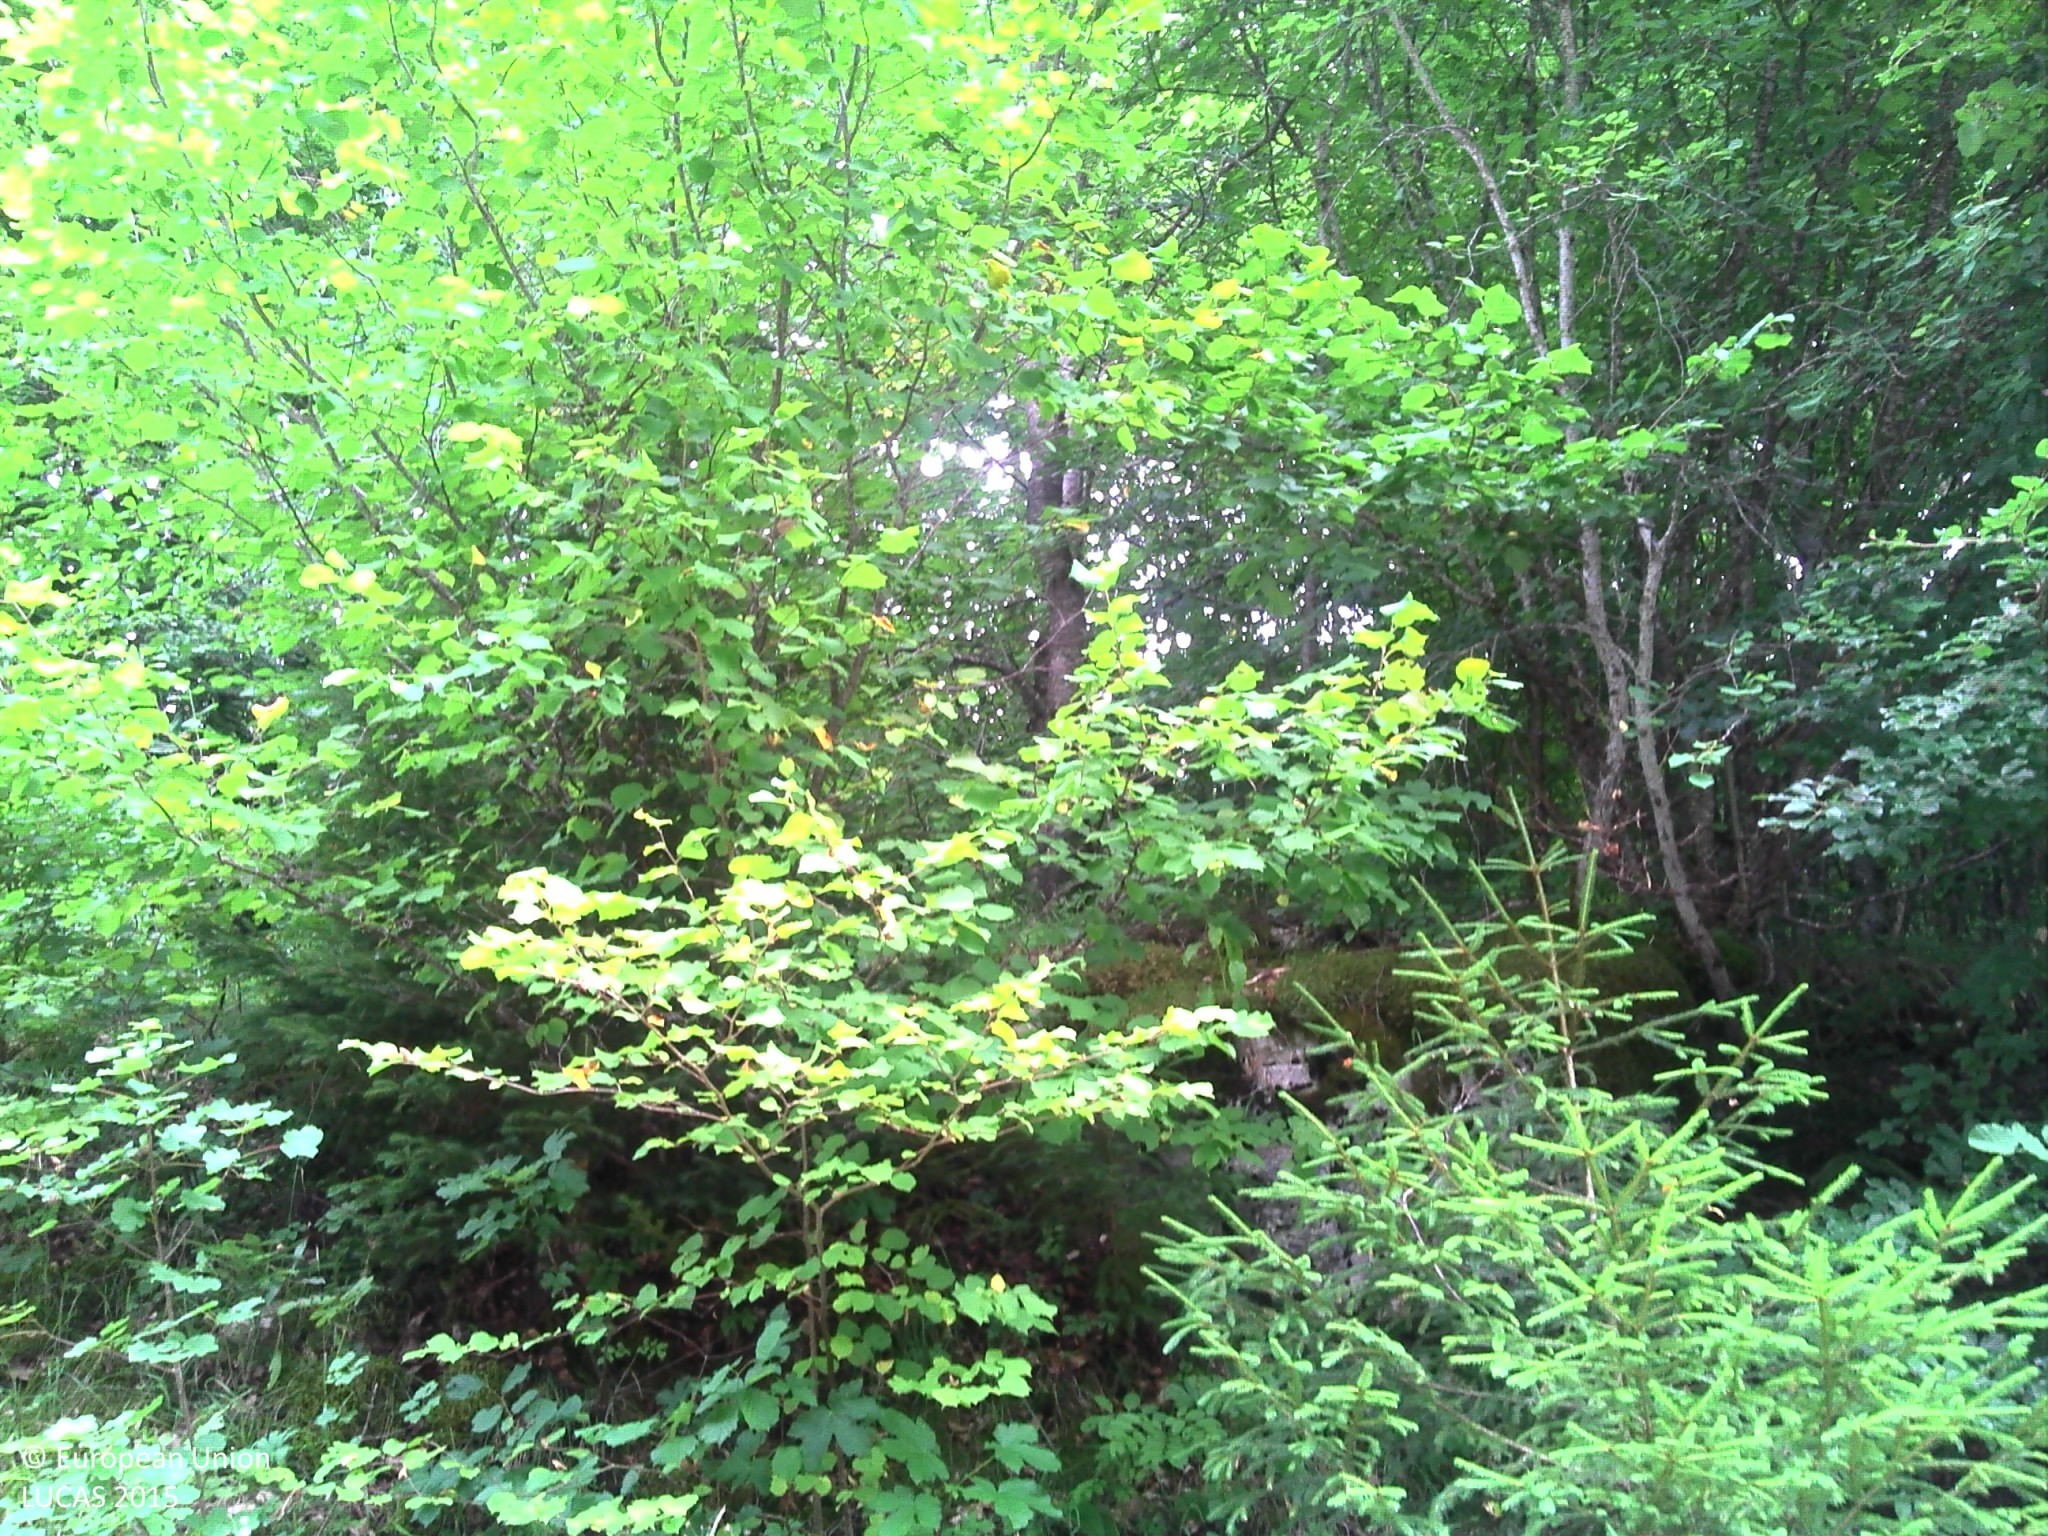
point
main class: Woodland
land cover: Other mixed woodland
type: alpine coniferous forest
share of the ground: > 75 %
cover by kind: coniferous forest trees 55 %, broadleaved forest trees 40 %, unconsolidated bare surface 5 %
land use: Semi-natural and natural areas not in use
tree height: > 5 m
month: July
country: FR
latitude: 44.8517
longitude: 5.5648
